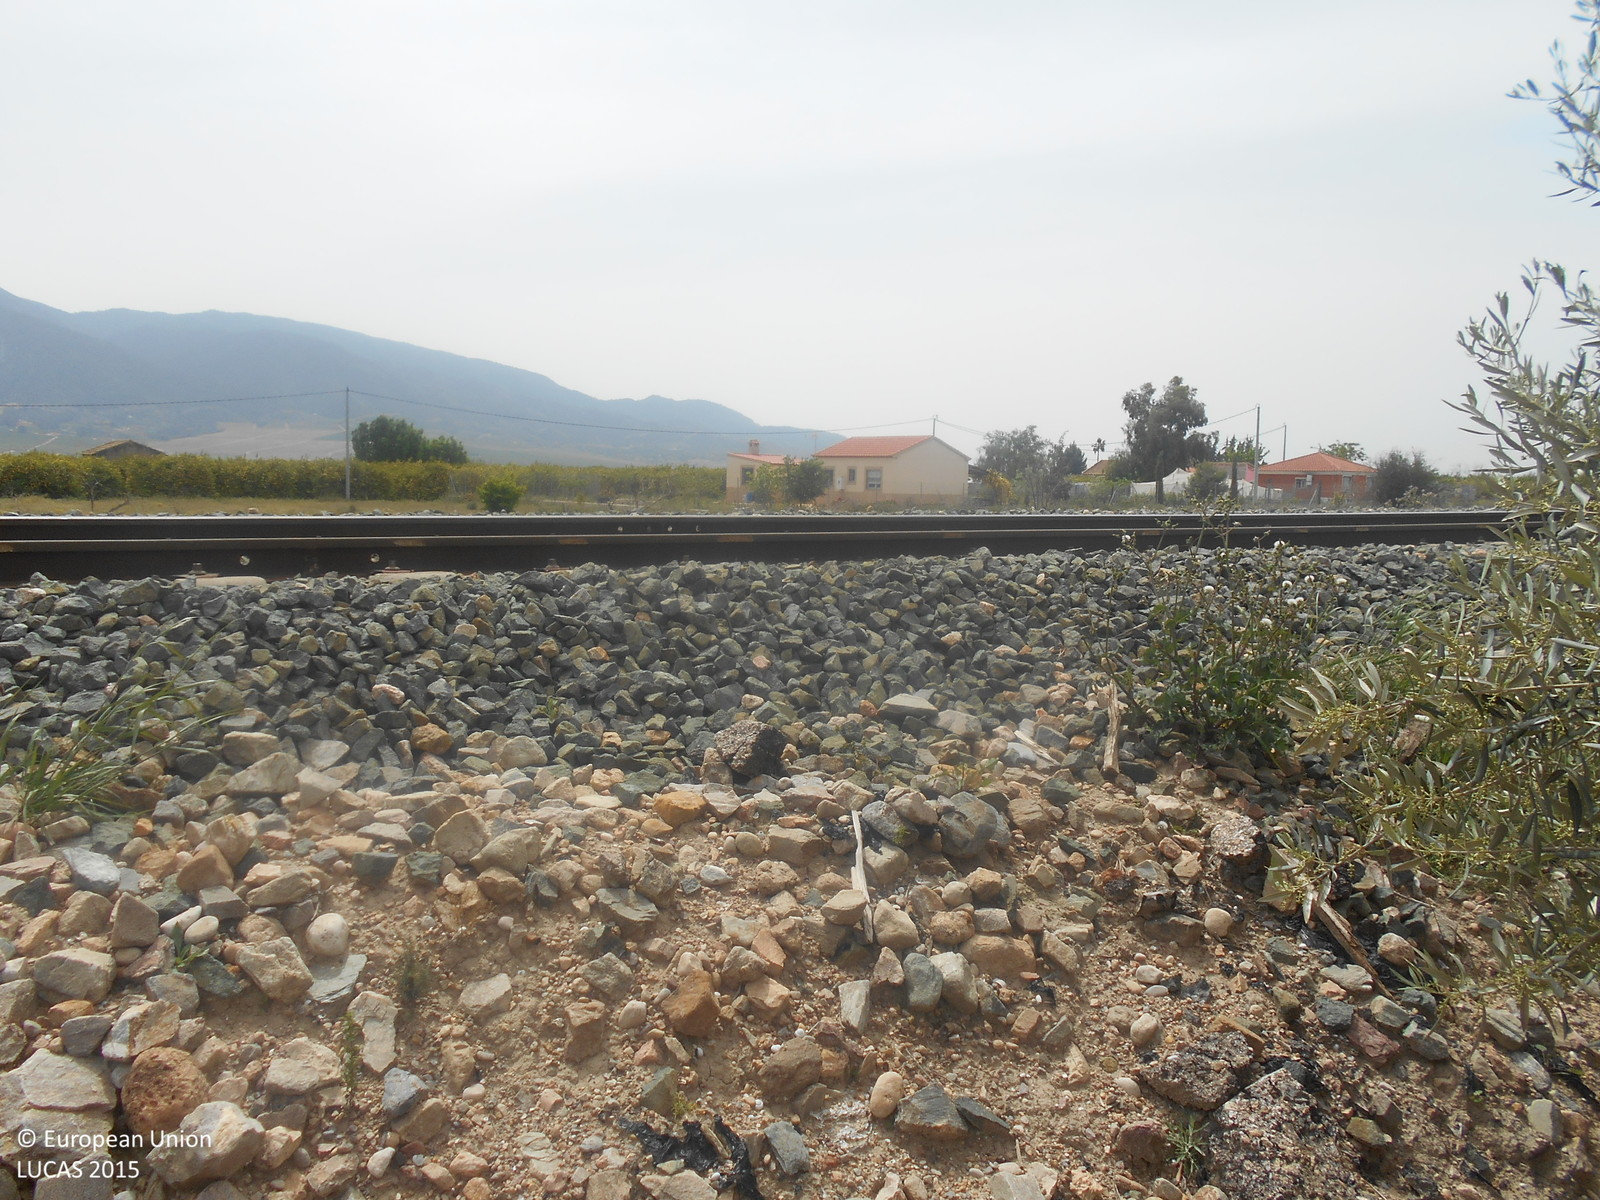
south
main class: Cropland
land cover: Olive groves
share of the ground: 10 - 25 %
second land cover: Other bare soil
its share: > 75 %
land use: Agriculture (excluding fallow land and kitchen gardens)
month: April
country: ES
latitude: 37.8897
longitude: -1.3432
